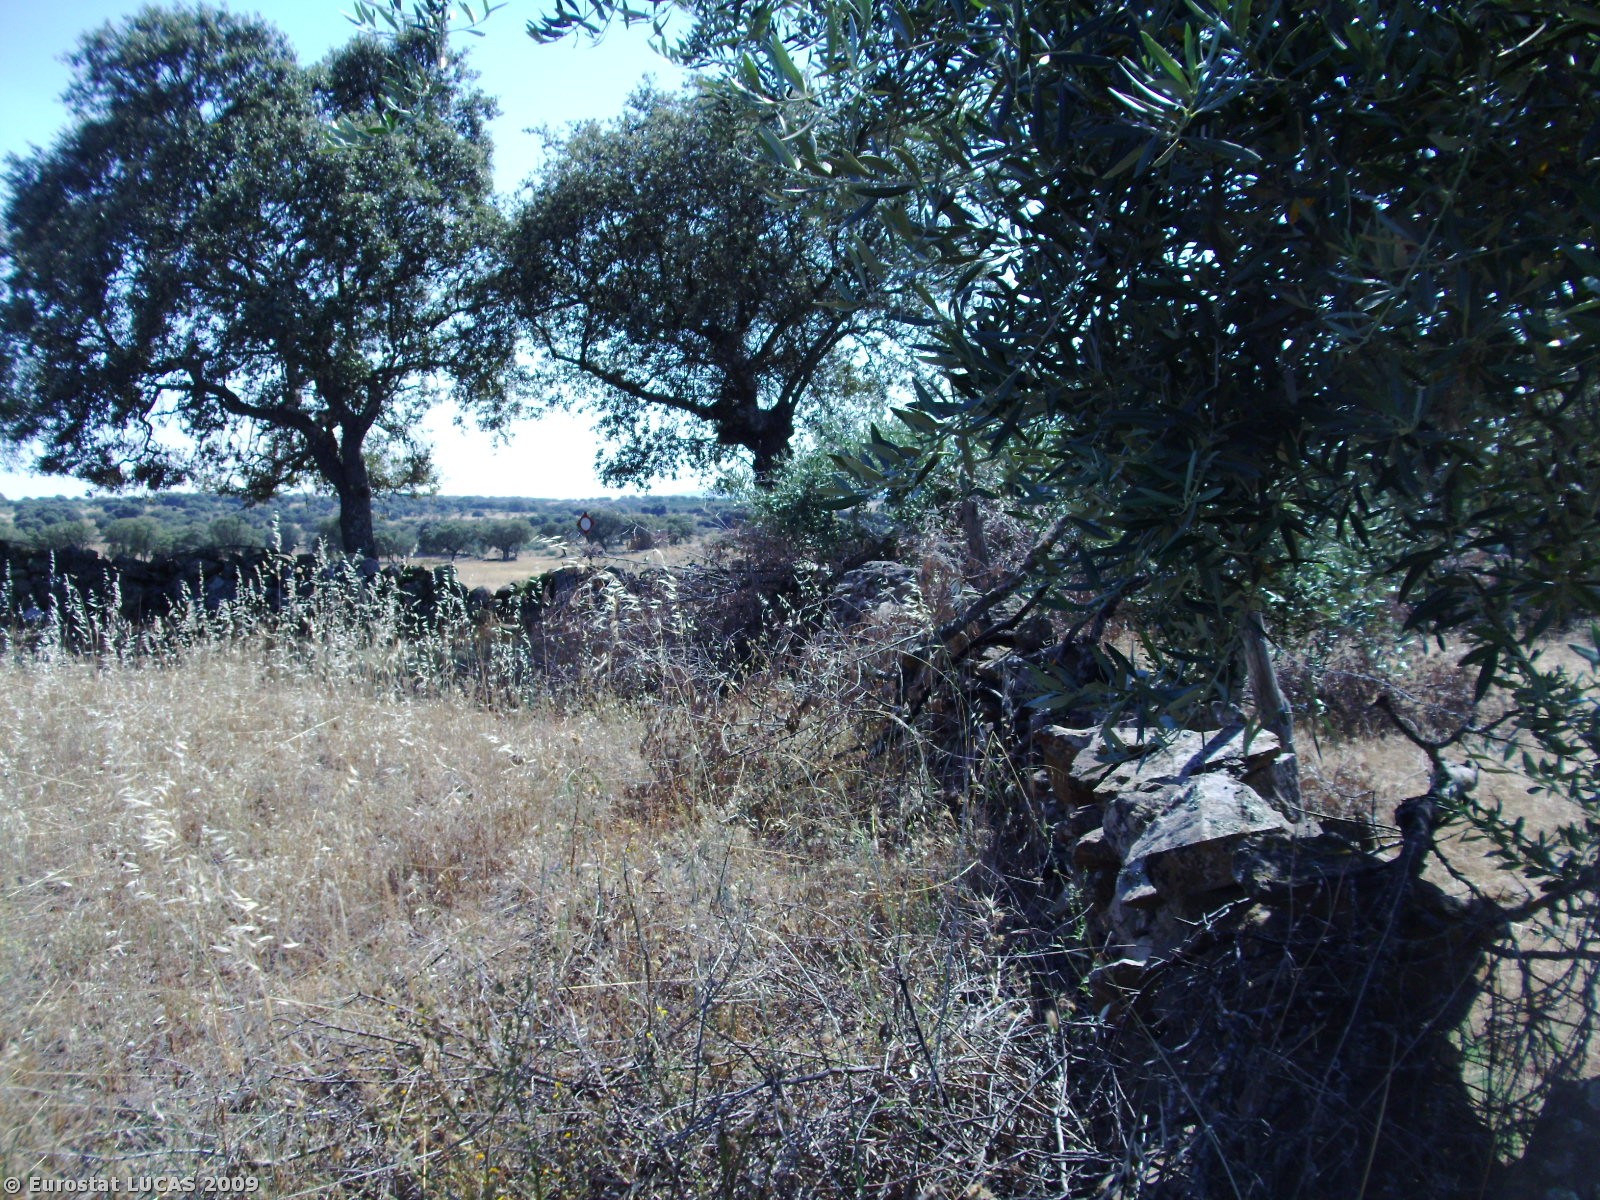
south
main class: Cropland
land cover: Olive groves
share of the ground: 50 - 75 %
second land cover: Spontaneously vegetated surfaces
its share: 25 - 50 %
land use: Agriculture (excluding fallow land and kitchen gardens)
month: June
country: PT
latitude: 39.8603
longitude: -7.0985
